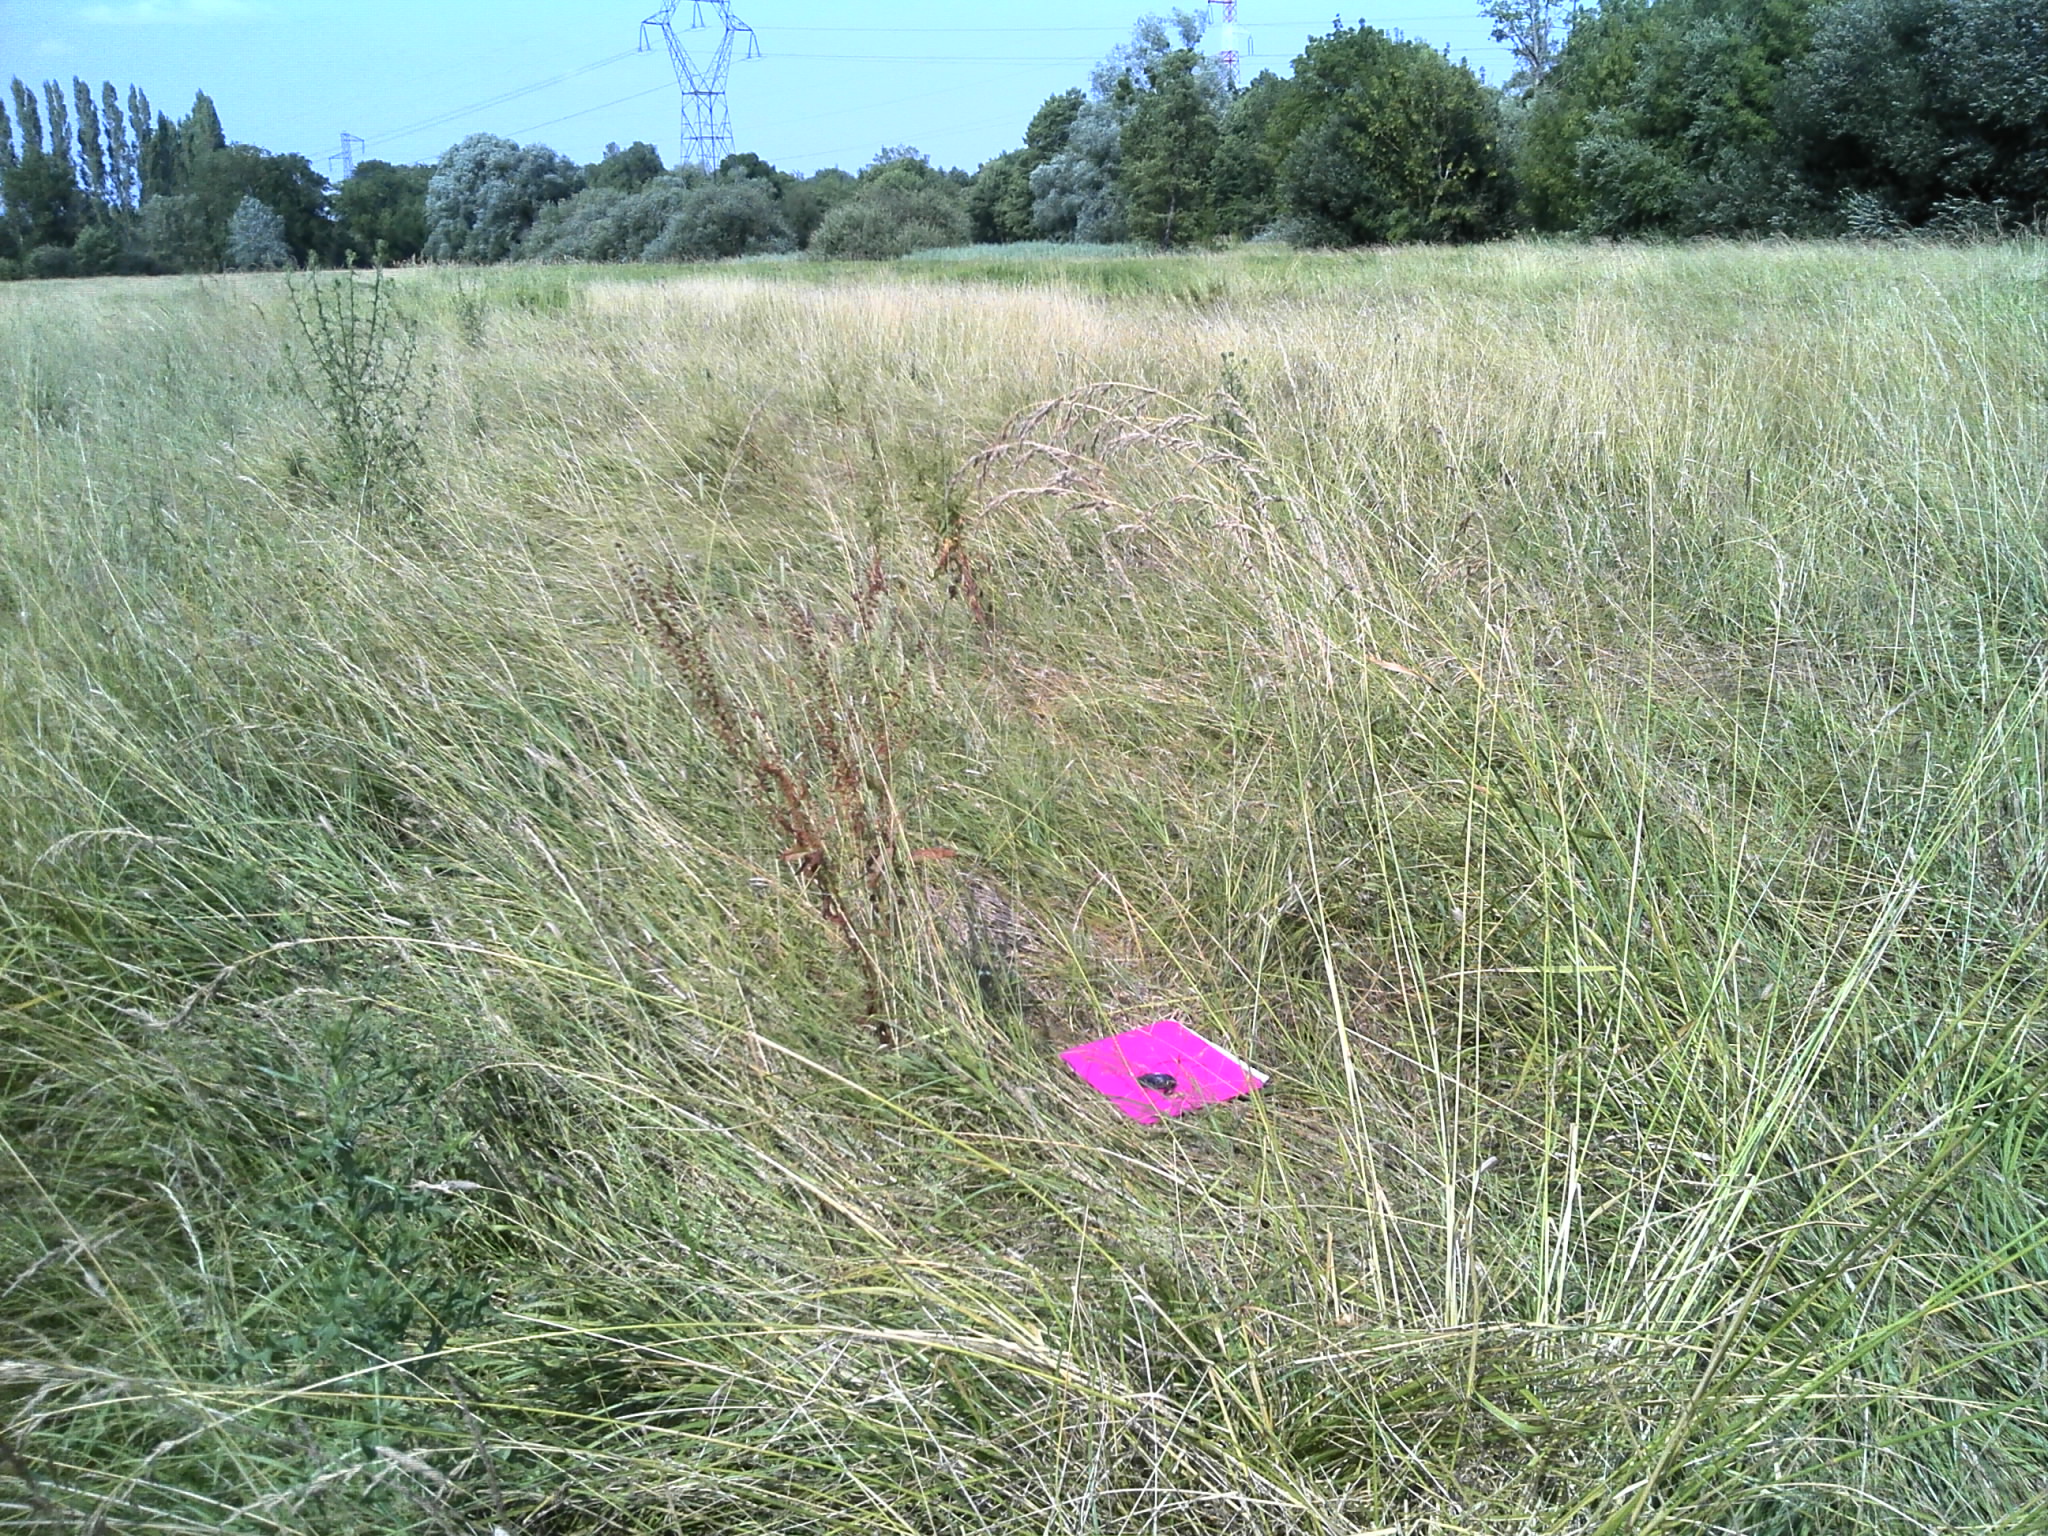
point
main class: Grassland
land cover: Grassland without tree/shrub cover
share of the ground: > 75 %
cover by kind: herbaceous plants 100 %
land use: Agriculture (excluding fallow land and kitchen gardens)
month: July
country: FR
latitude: 46.8021
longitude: 1.6429
